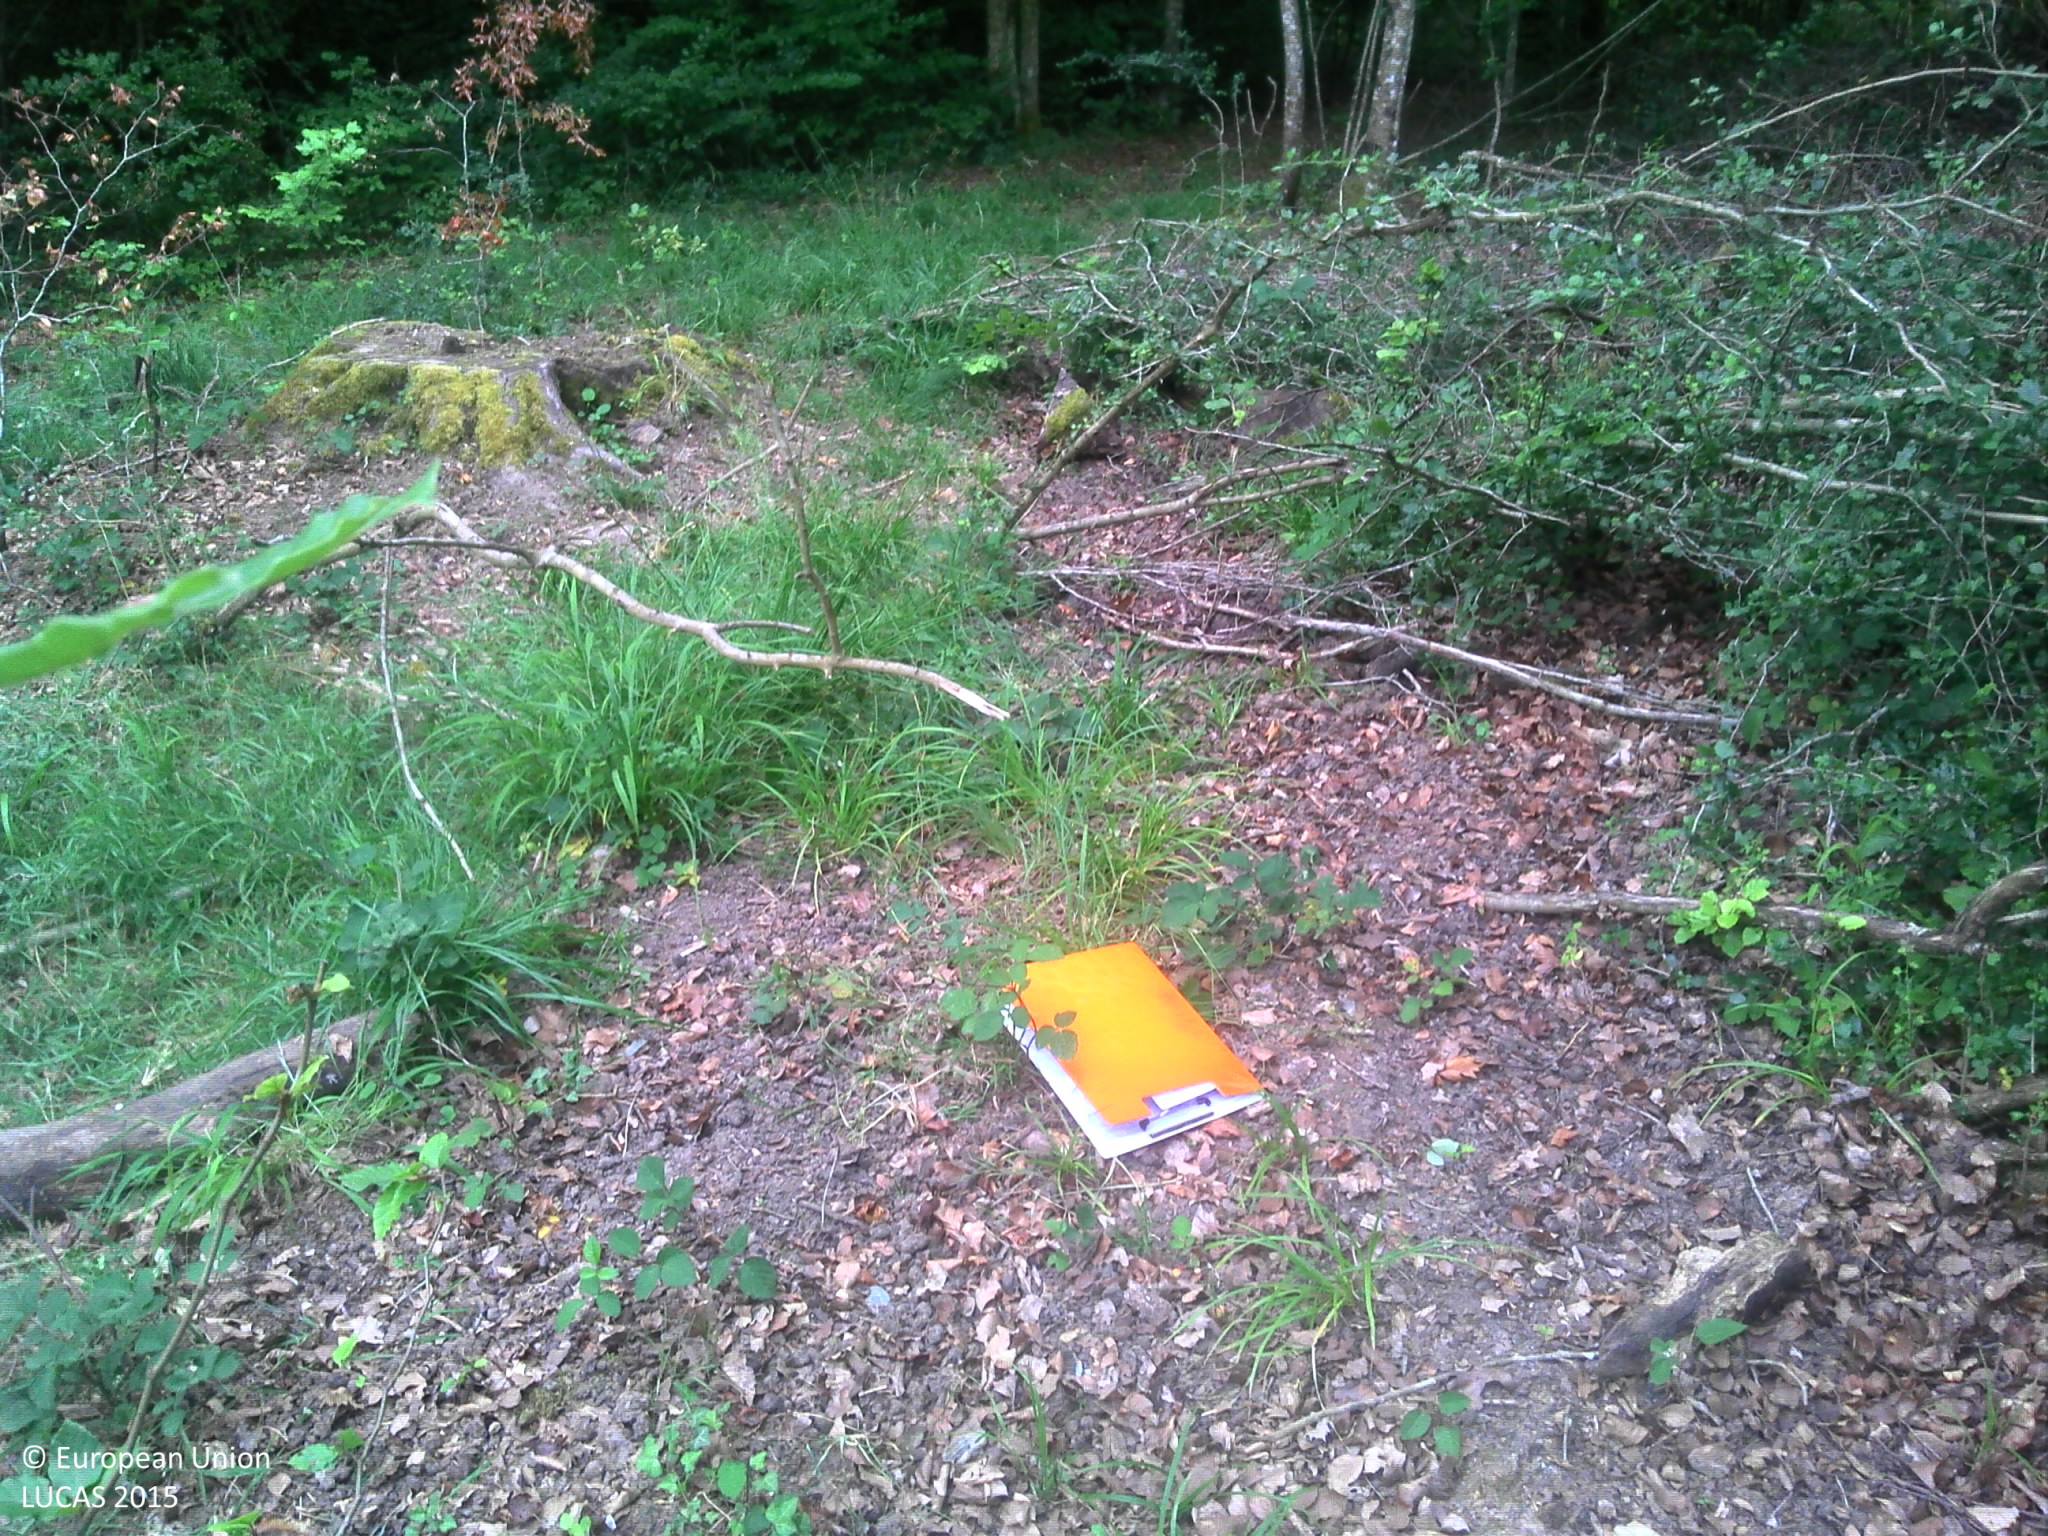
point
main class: Woodland
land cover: Broadleaved woodland
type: beech forest
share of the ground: > 75 %
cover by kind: broadleaved forest trees 90 %, herbaceous plants 10 %
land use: Forestry
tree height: > 5 m
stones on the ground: < 10 %
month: July
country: FR
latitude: 48.1790
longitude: 4.9284
